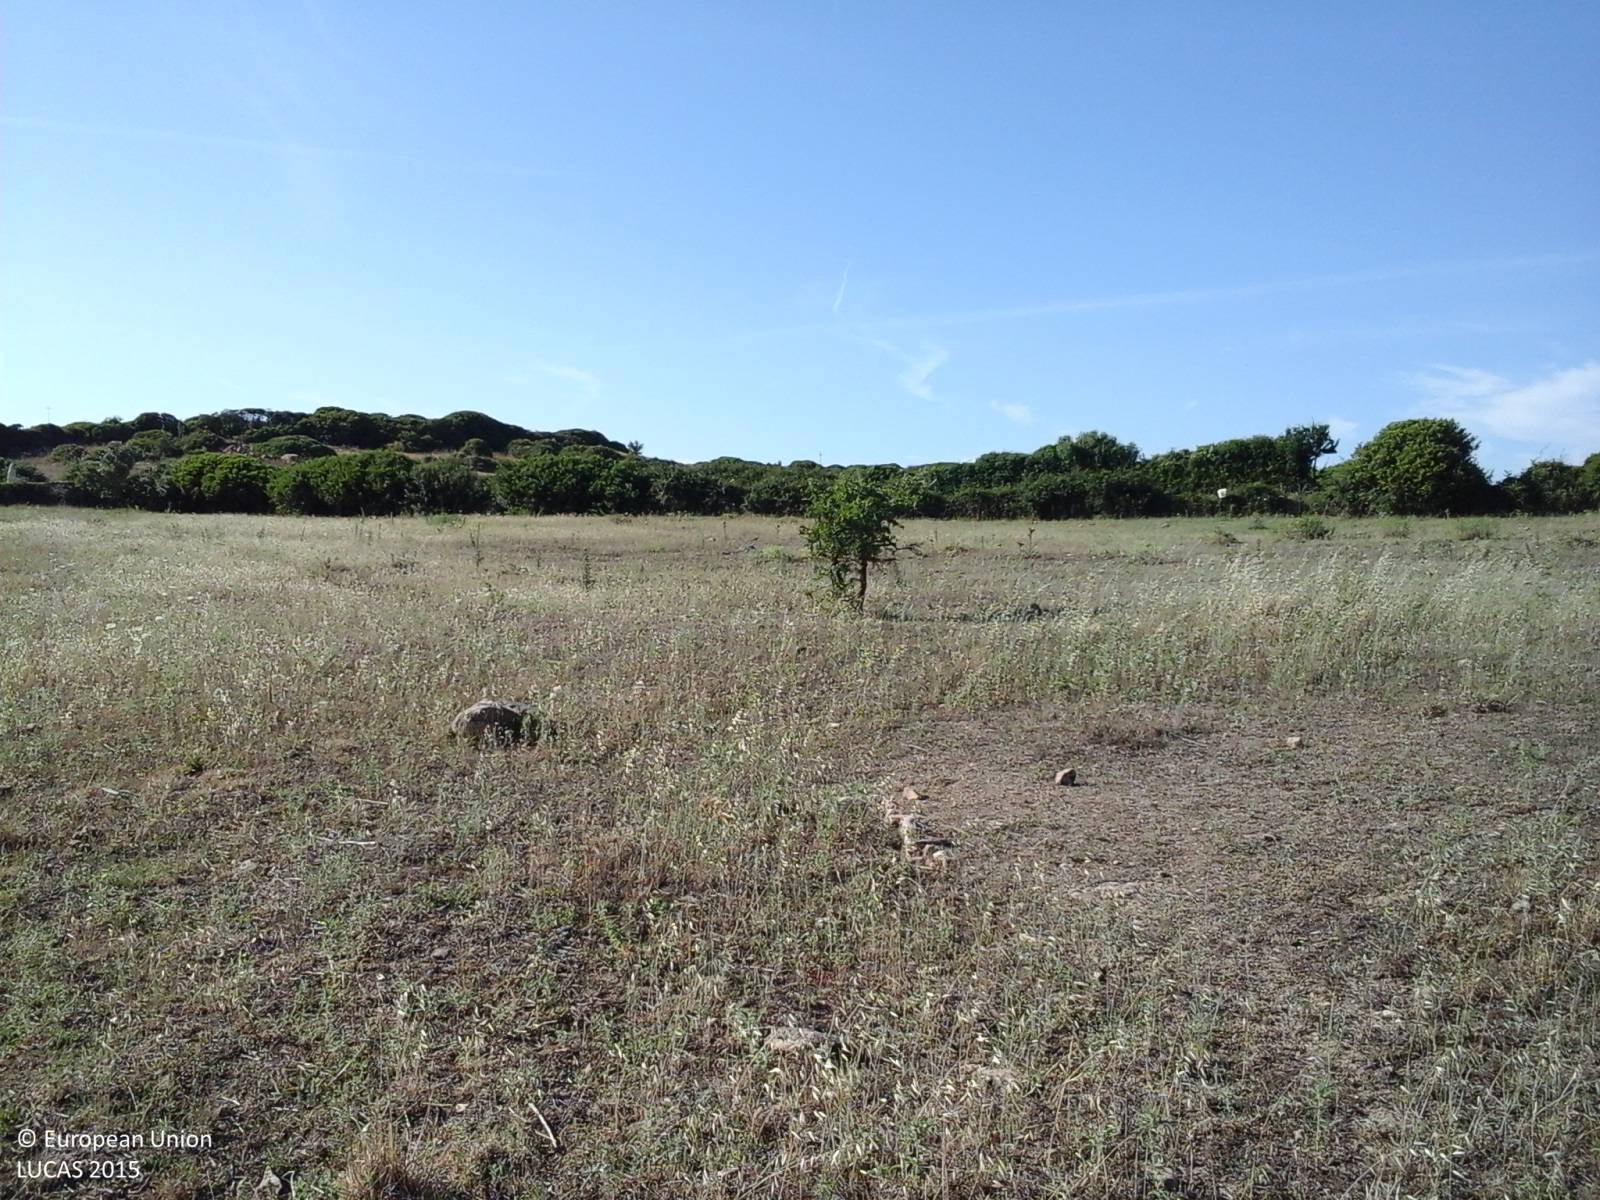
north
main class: Grassland
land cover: Grassland without tree/shrub cover
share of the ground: > 75 %
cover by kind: herbaceous plants 100 %
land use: Agriculture (excluding fallow land and kitchen gardens)
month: June
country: IT
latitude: 39.8094
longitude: 8.9895
